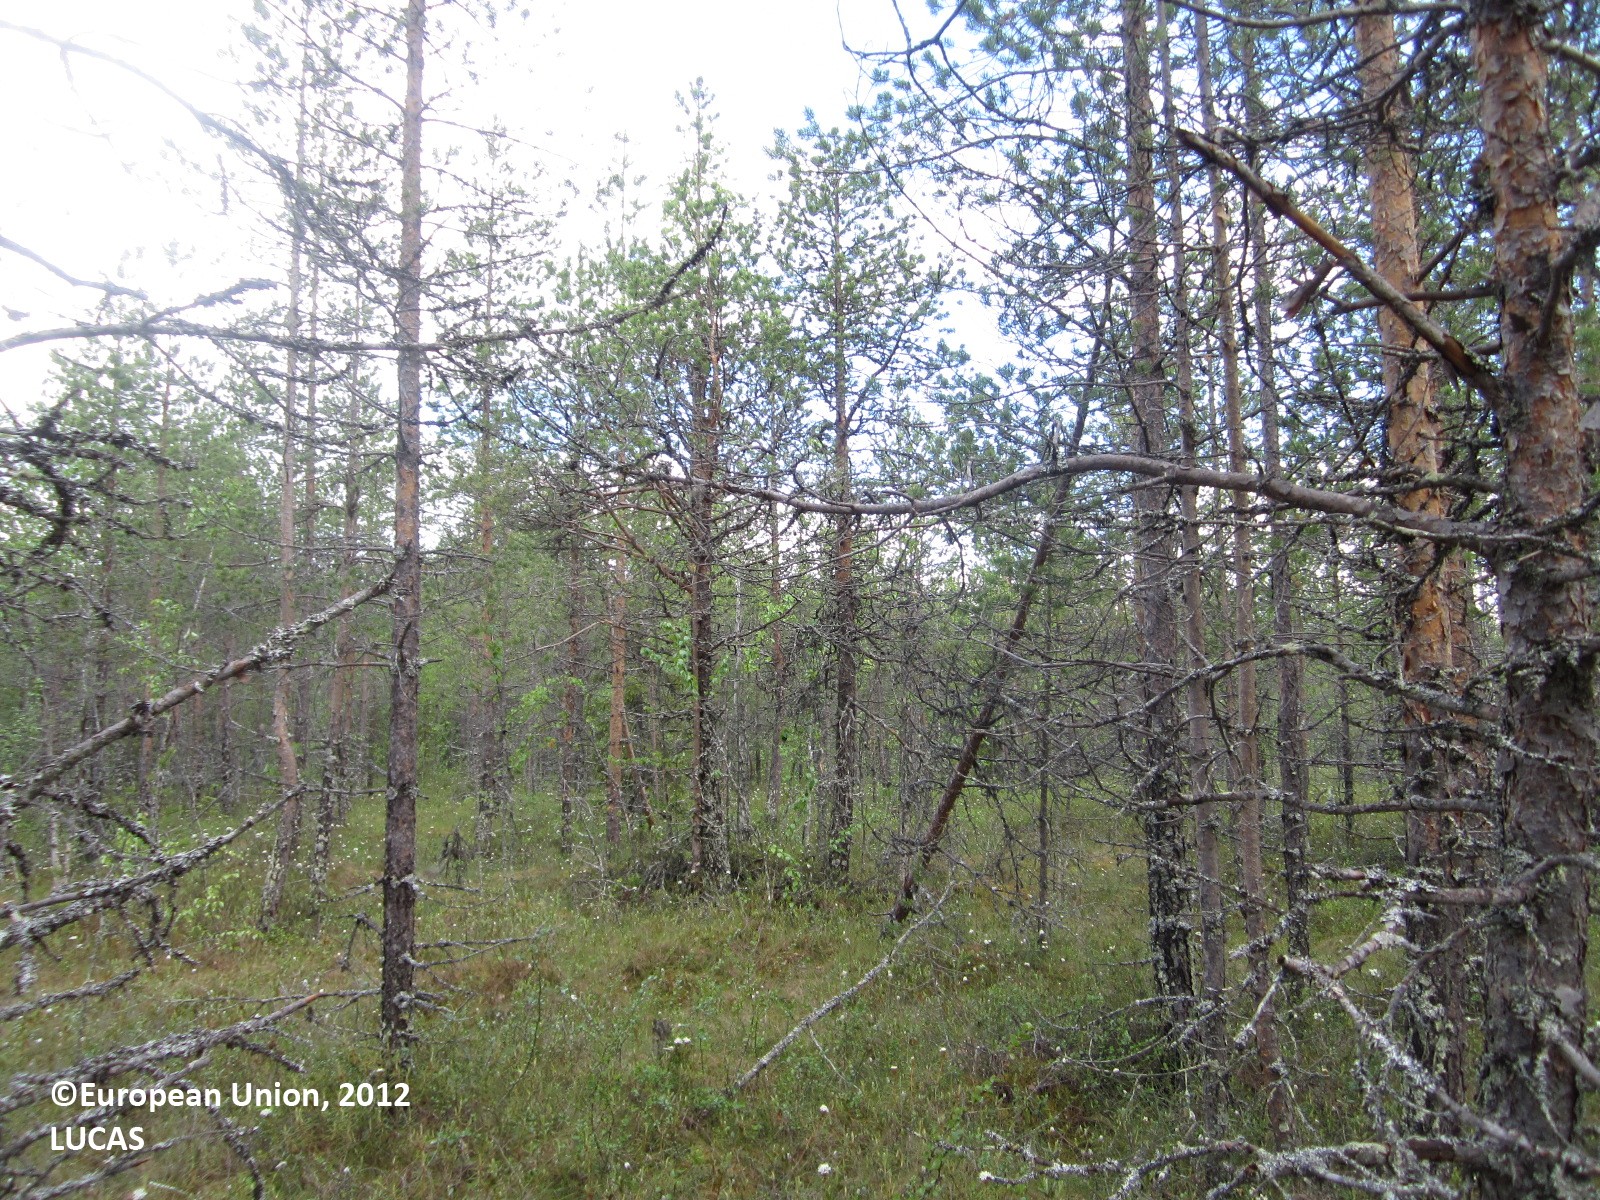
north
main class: Woodland
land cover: Pine dominated coniferous woodland
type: boreal forest
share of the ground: 50 - 75 %
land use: Forestry
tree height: > 5 m
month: June
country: FI
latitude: 64.4158
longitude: 29.7118
